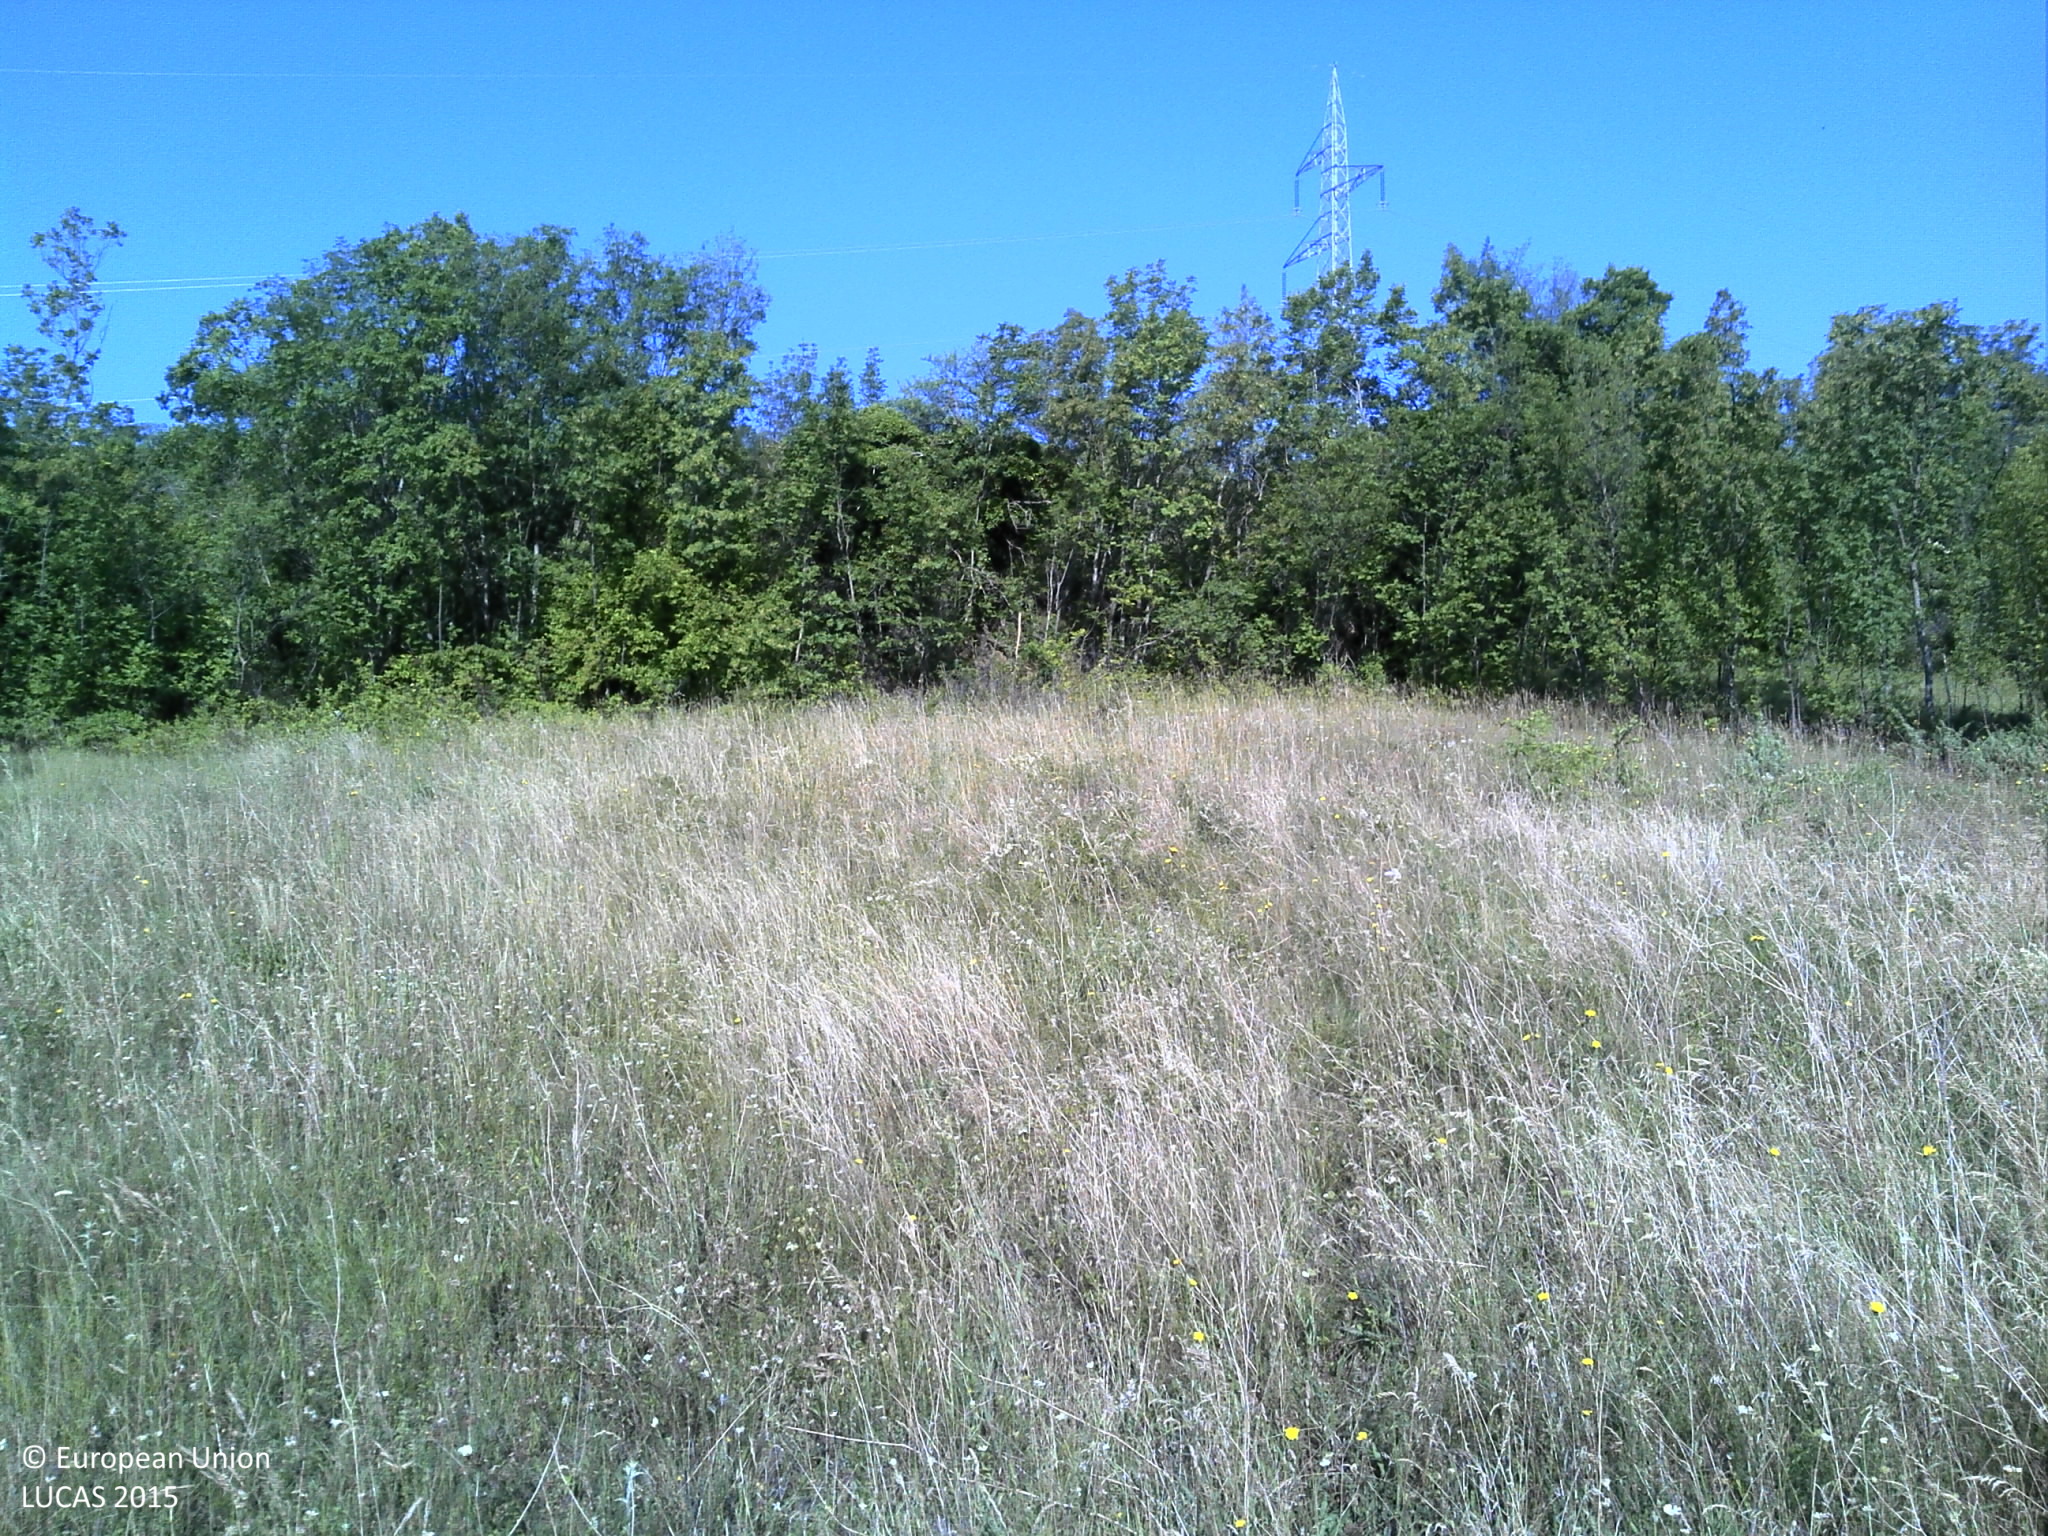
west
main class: Grassland
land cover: Grassland without tree/shrub cover
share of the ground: > 75 %
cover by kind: herbaceous plants 100 %
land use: Agriculture (excluding fallow land and kitchen gardens)
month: July
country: HR
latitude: 43.8546
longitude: 16.2495
